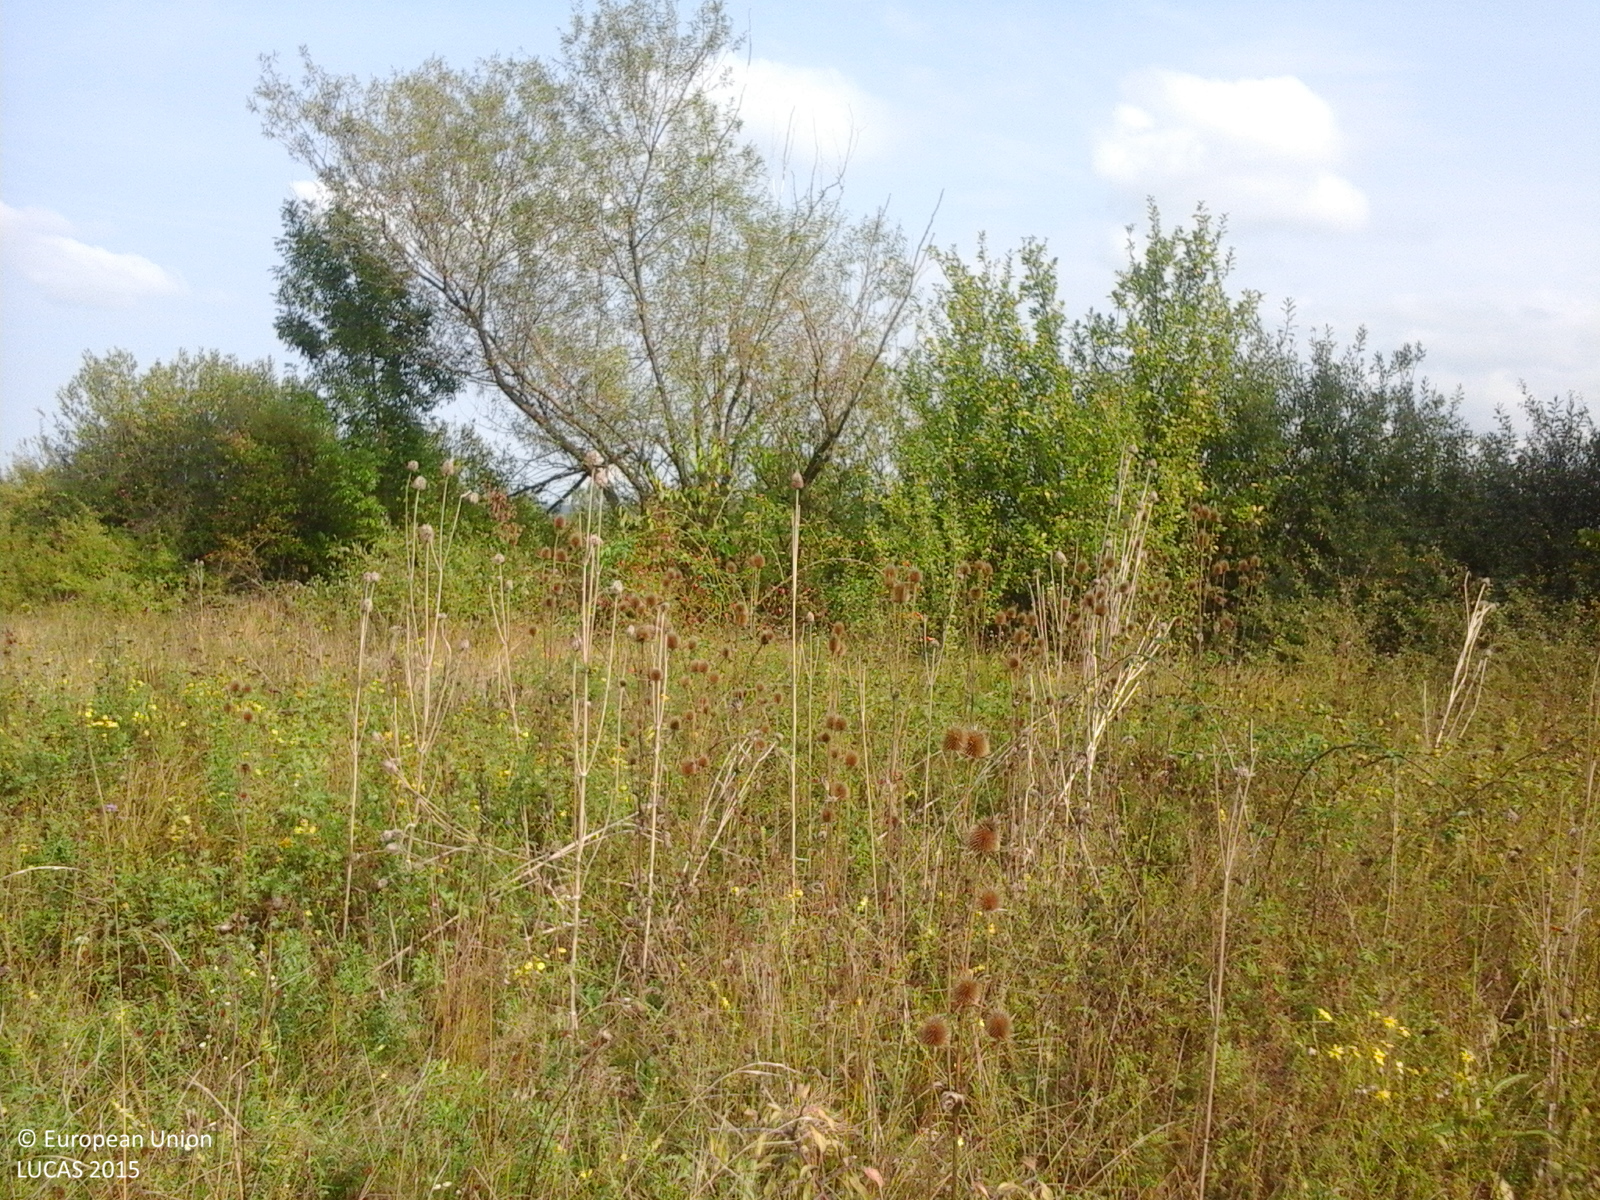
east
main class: Grassland
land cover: Spontaneously vegetated surfaces
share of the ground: > 75 %
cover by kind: herbaceous plants 100 %
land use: Fallow land
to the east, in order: Spontaneously vegetated surfaces; Abandoned hedges; Spontaneously vegetated surfaces; Maize; Spontaneously vegetated surfaces; Single bushes/trees; Spontaneously vegetated surfaces; Tracks
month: September
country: RO
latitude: 45.8398
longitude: 22.2889
